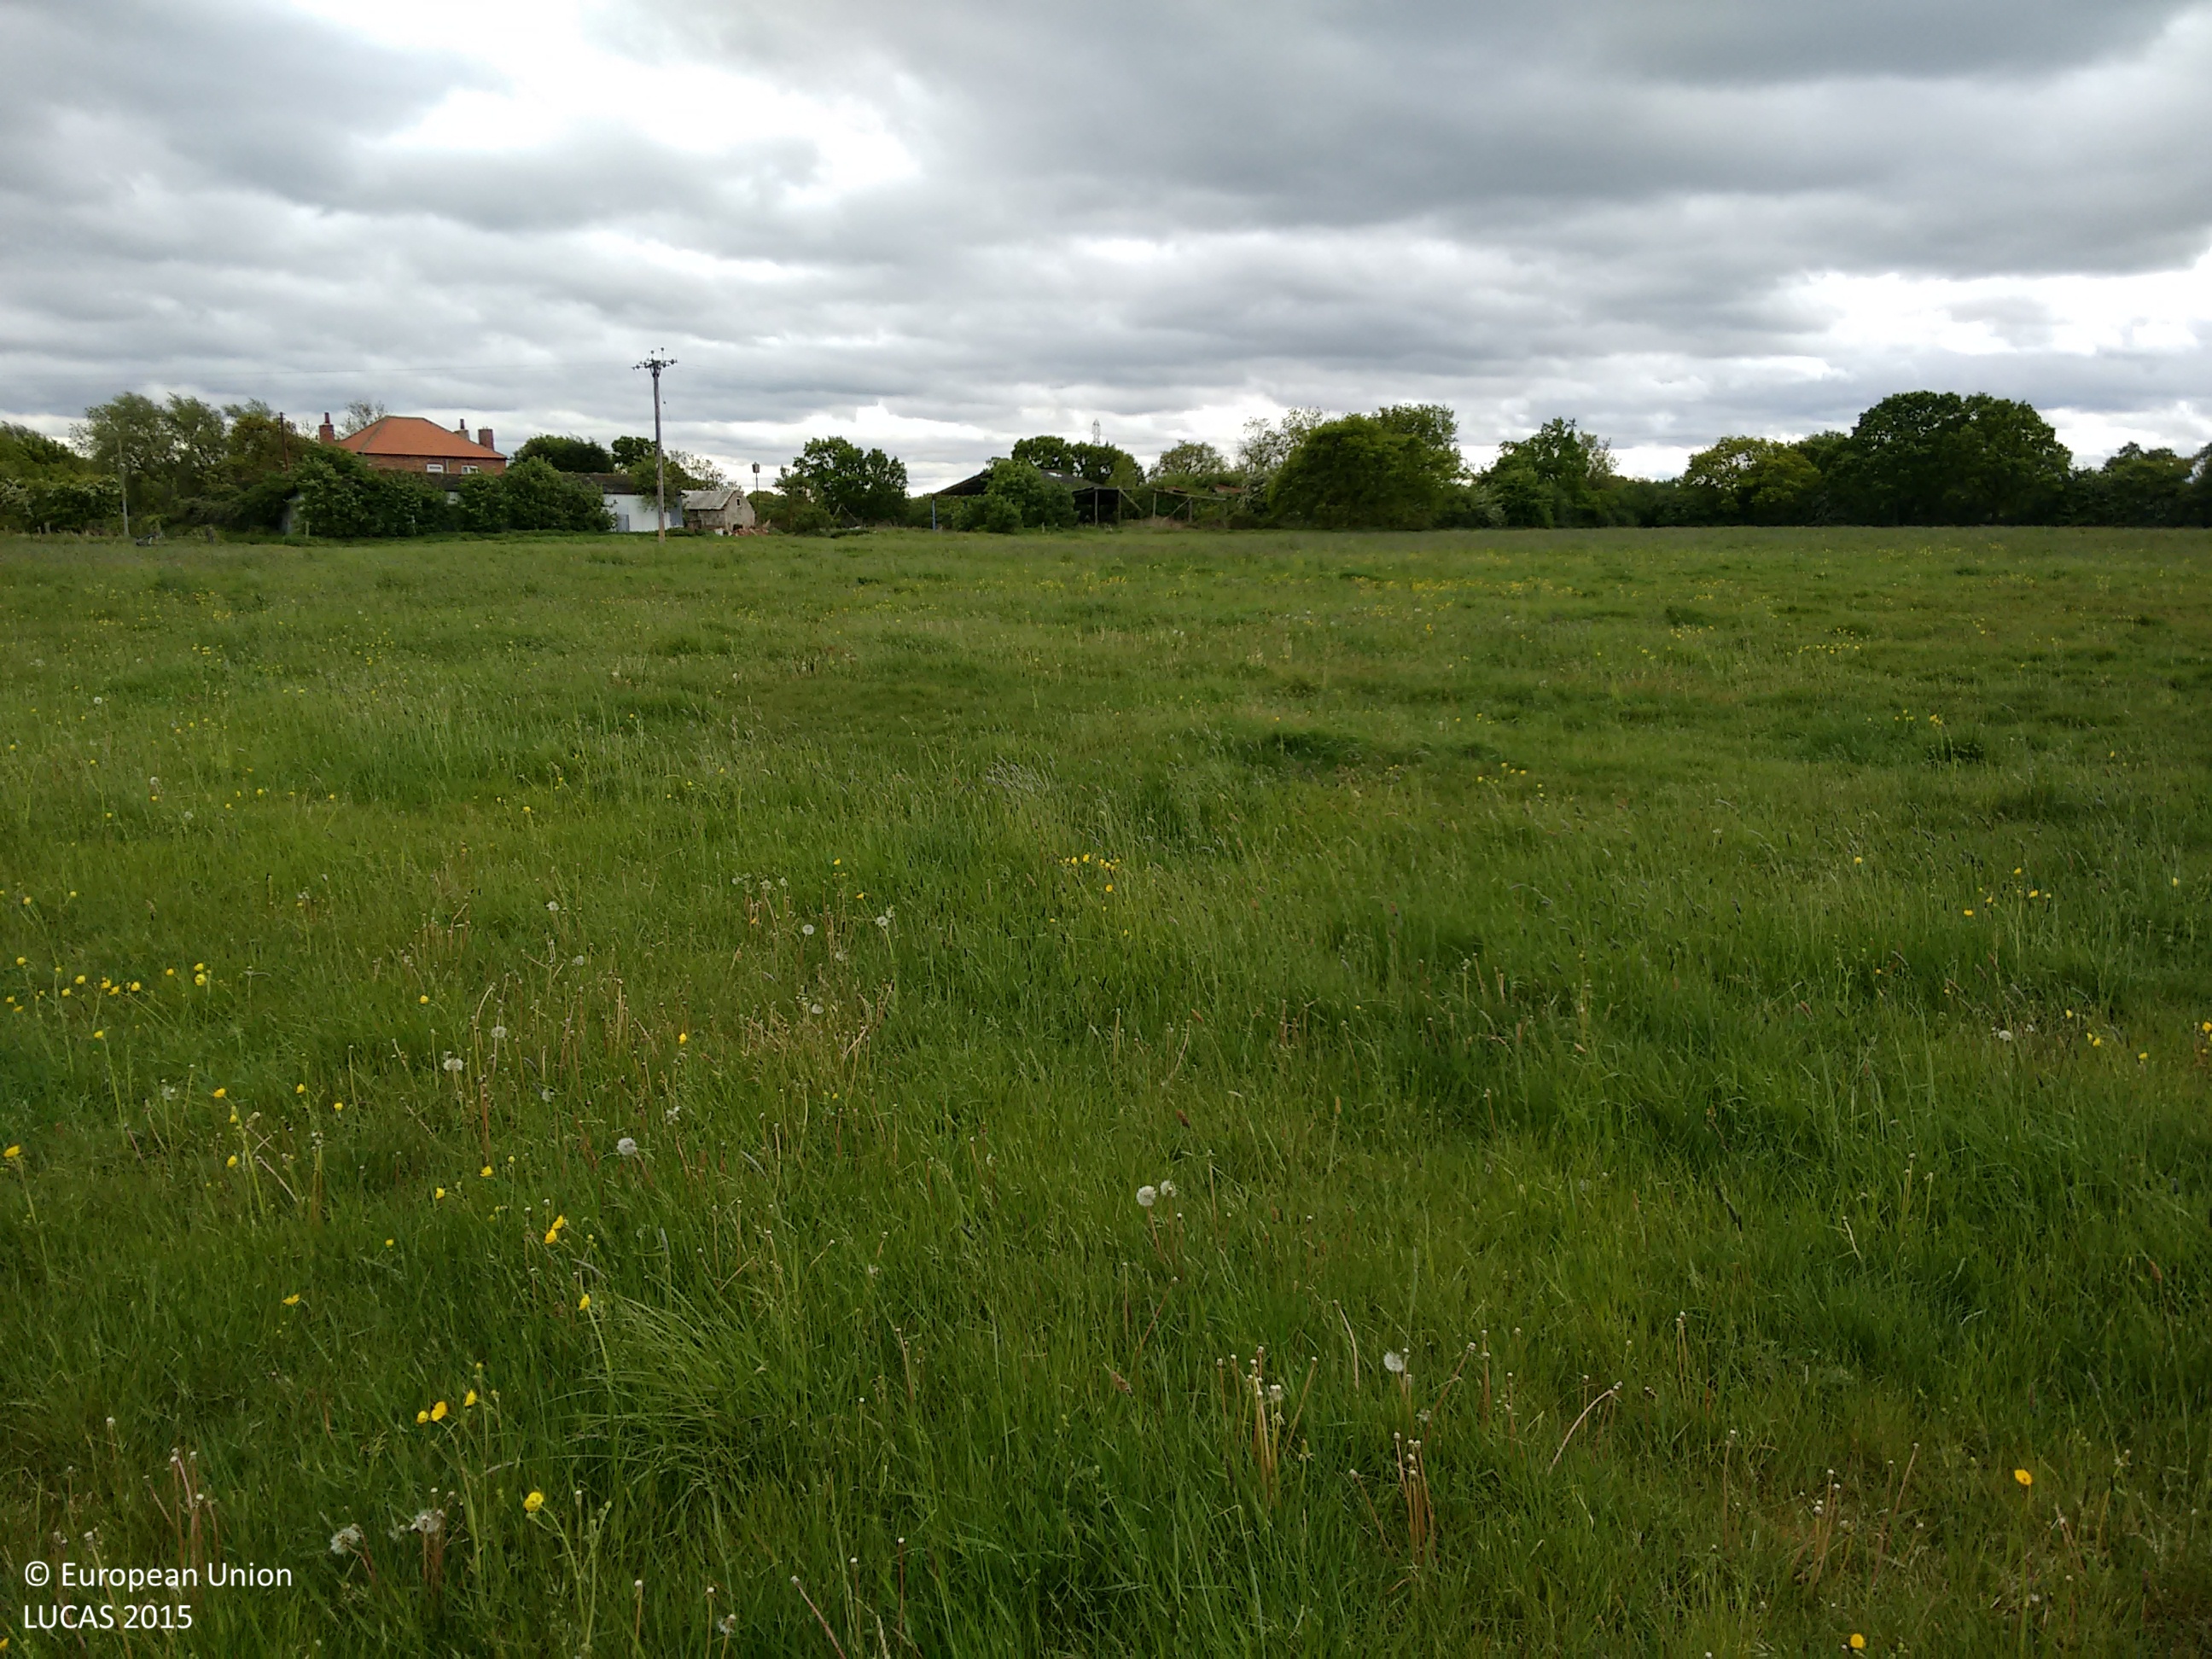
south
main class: Grassland
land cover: Grassland without tree/shrub cover
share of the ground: > 75 %
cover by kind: herbaceous plants 100 %
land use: Agriculture (excluding fallow land and kitchen gardens)
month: May
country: GB
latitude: 53.6397
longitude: -1.0398
